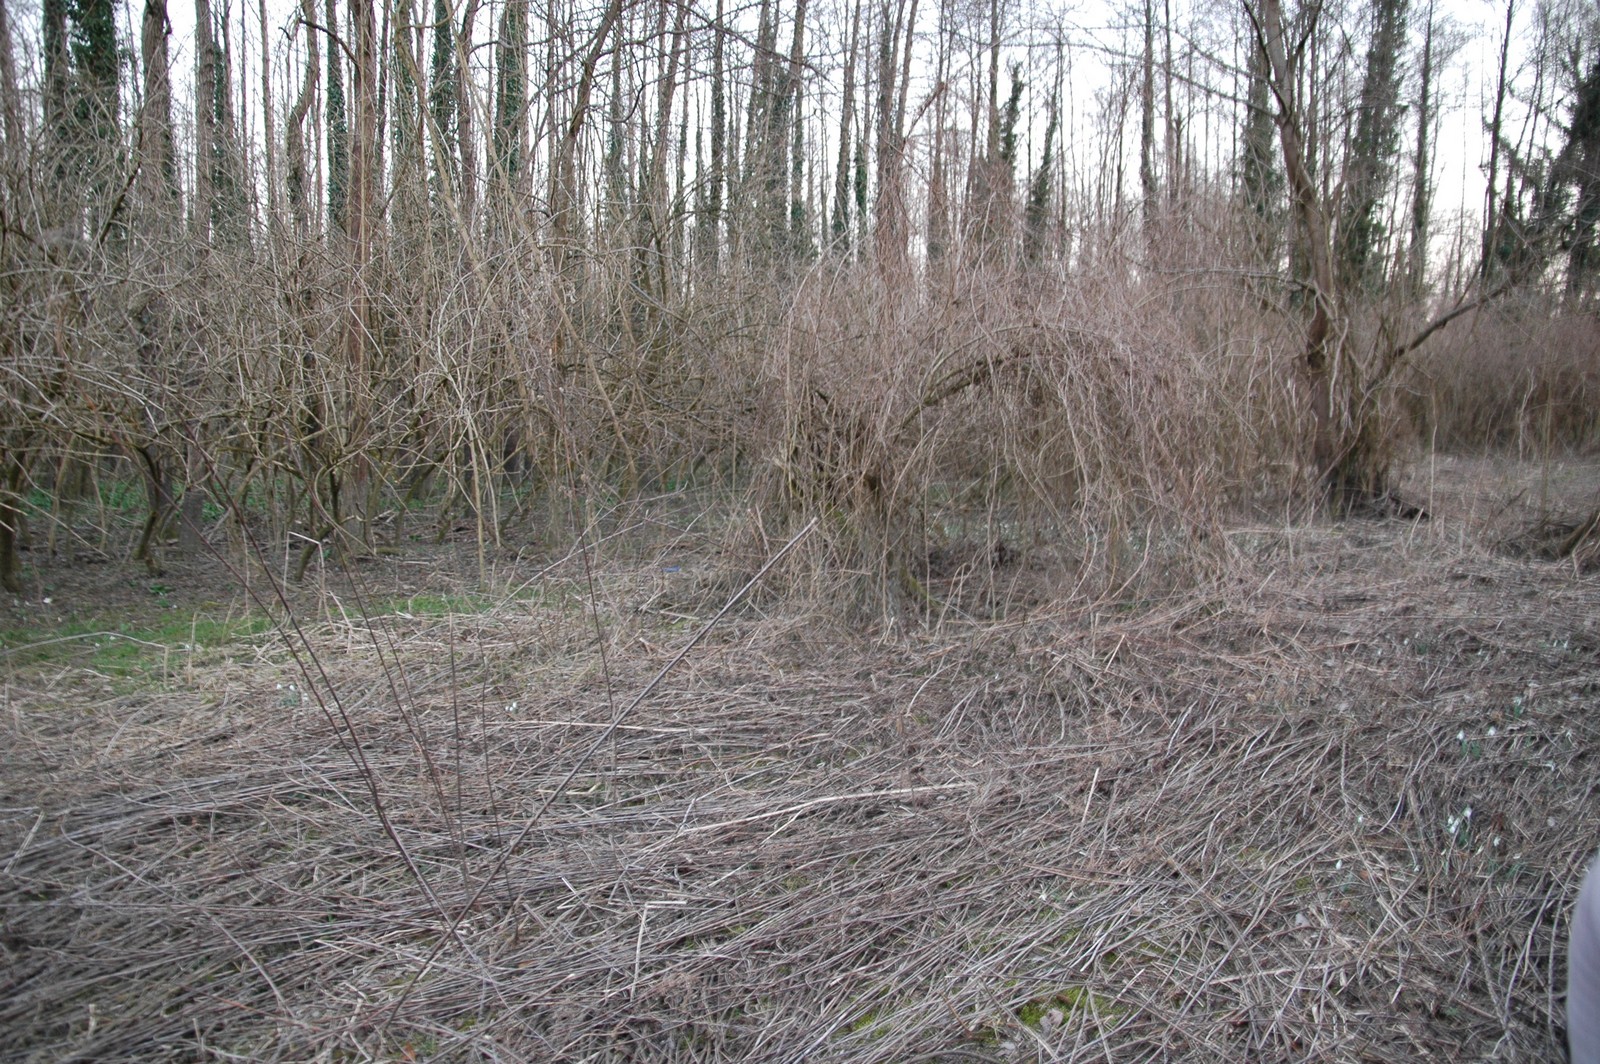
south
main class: Woodland
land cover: Broadleaved woodland
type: mesophytic deciduous forest
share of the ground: > 75 %
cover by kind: broadleaved forest trees 50 %, shrubs 35 %, herbaceous plants 15 %
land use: Forestry
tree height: > 5 m
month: March
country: HR
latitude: 46.3924
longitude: 16.1250
